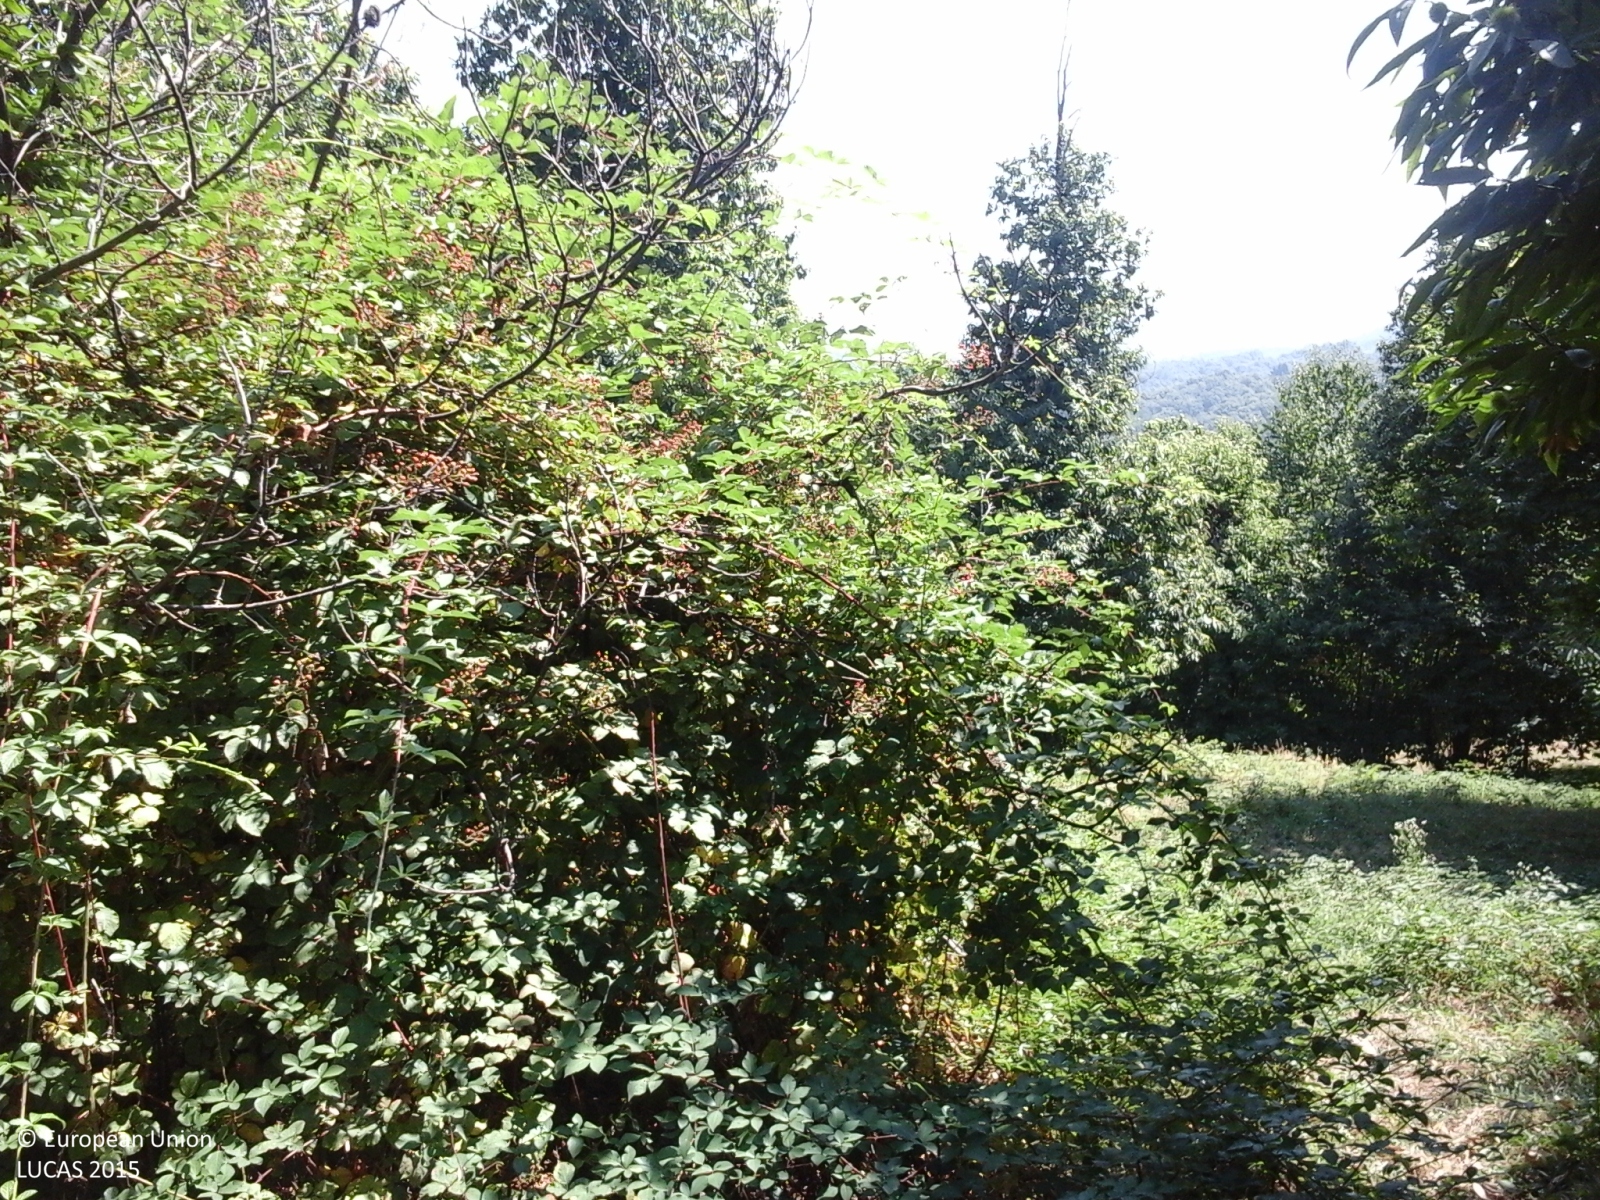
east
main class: Woodland
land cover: Broadleaved woodland
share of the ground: > 75 %
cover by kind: broadleaved forest trees 70 %, herbaceous plants 30 %
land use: Agriculture (excluding fallow land and kitchen gardens)
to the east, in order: Broadleaved woodland; Grassland with sparse tree/shrub cover; Nuts trees; Tracks; Nuts trees; Grassland without tree/shrub cover; Broadleaved woodland; Shrubland with sparse tree cover; Broadleaved woodland
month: August
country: IT
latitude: 44.3275
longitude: 7.8103
